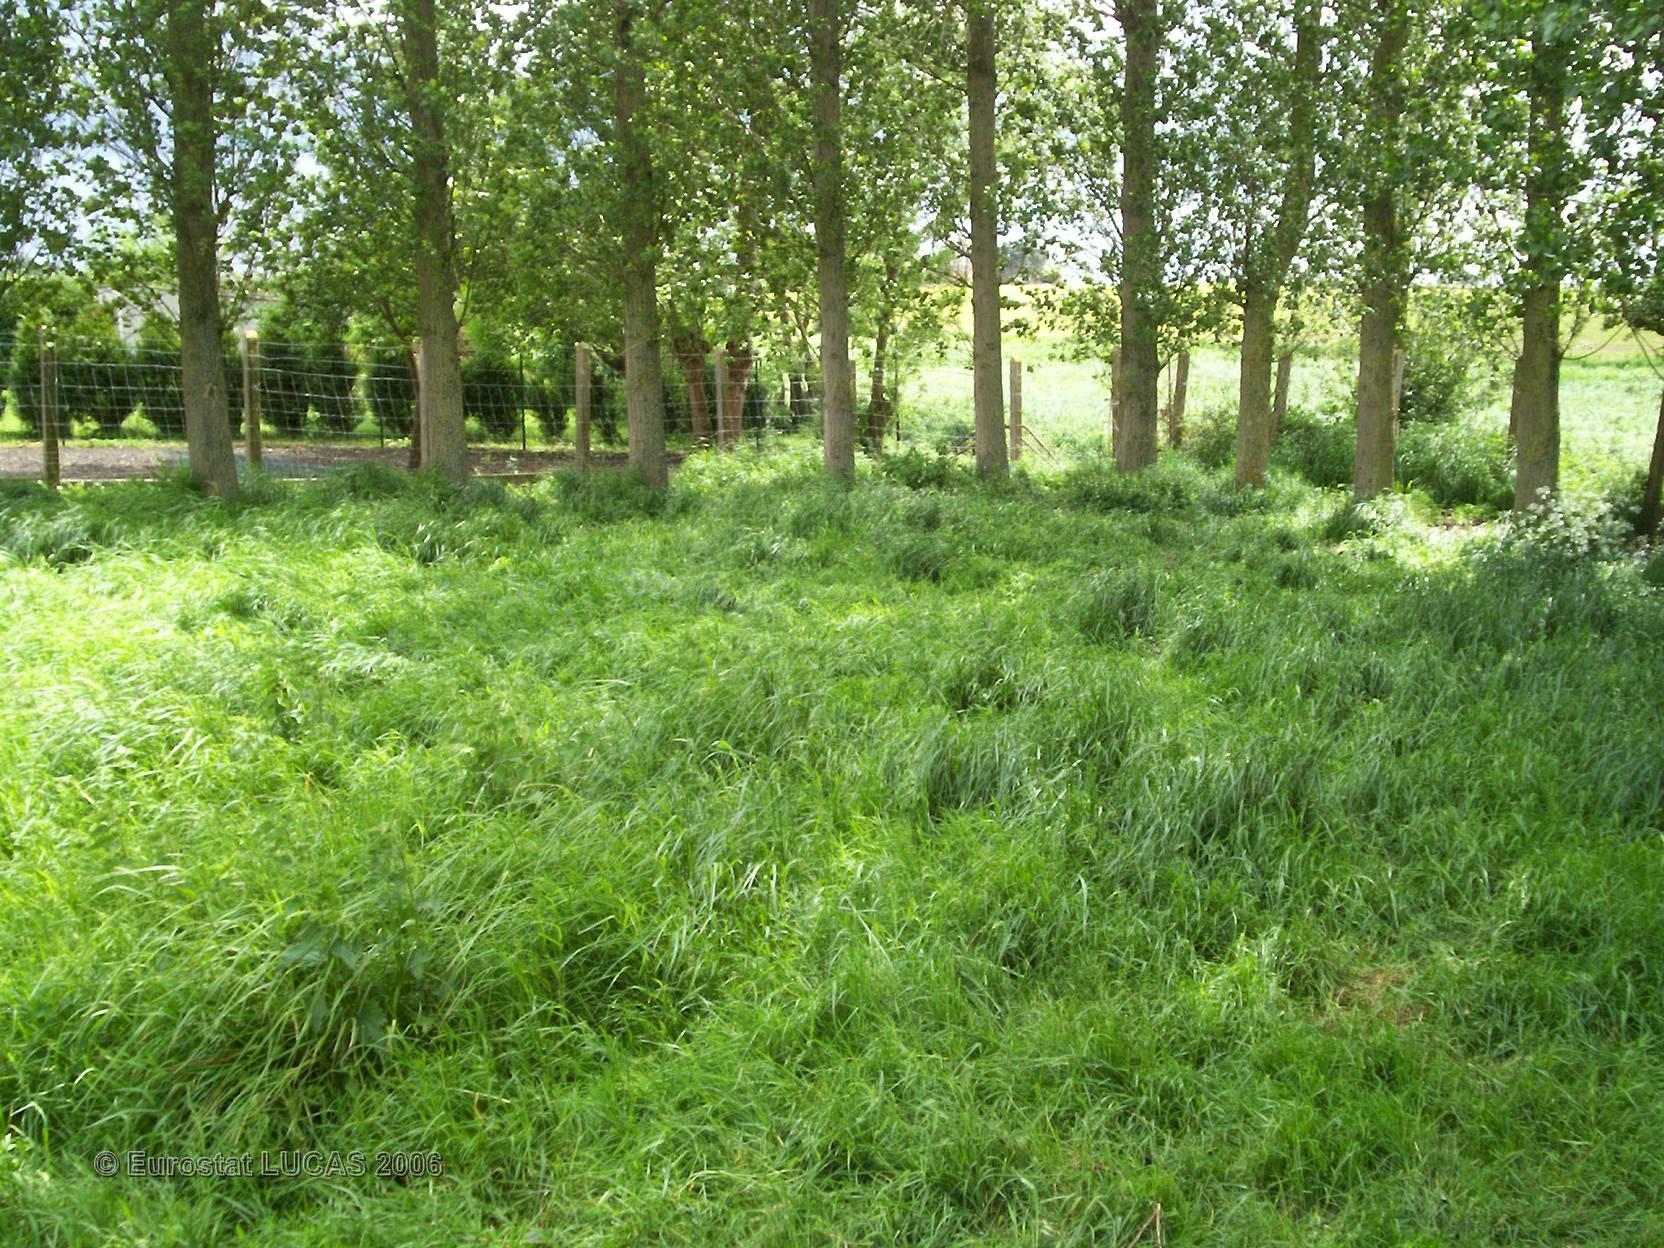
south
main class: Grassland
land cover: Grassland with sparse tree/shrub cover
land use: Agriculture (excluding fallow land and kitchen gardens)
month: May
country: FR
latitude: 50.9117
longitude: 2.4918
